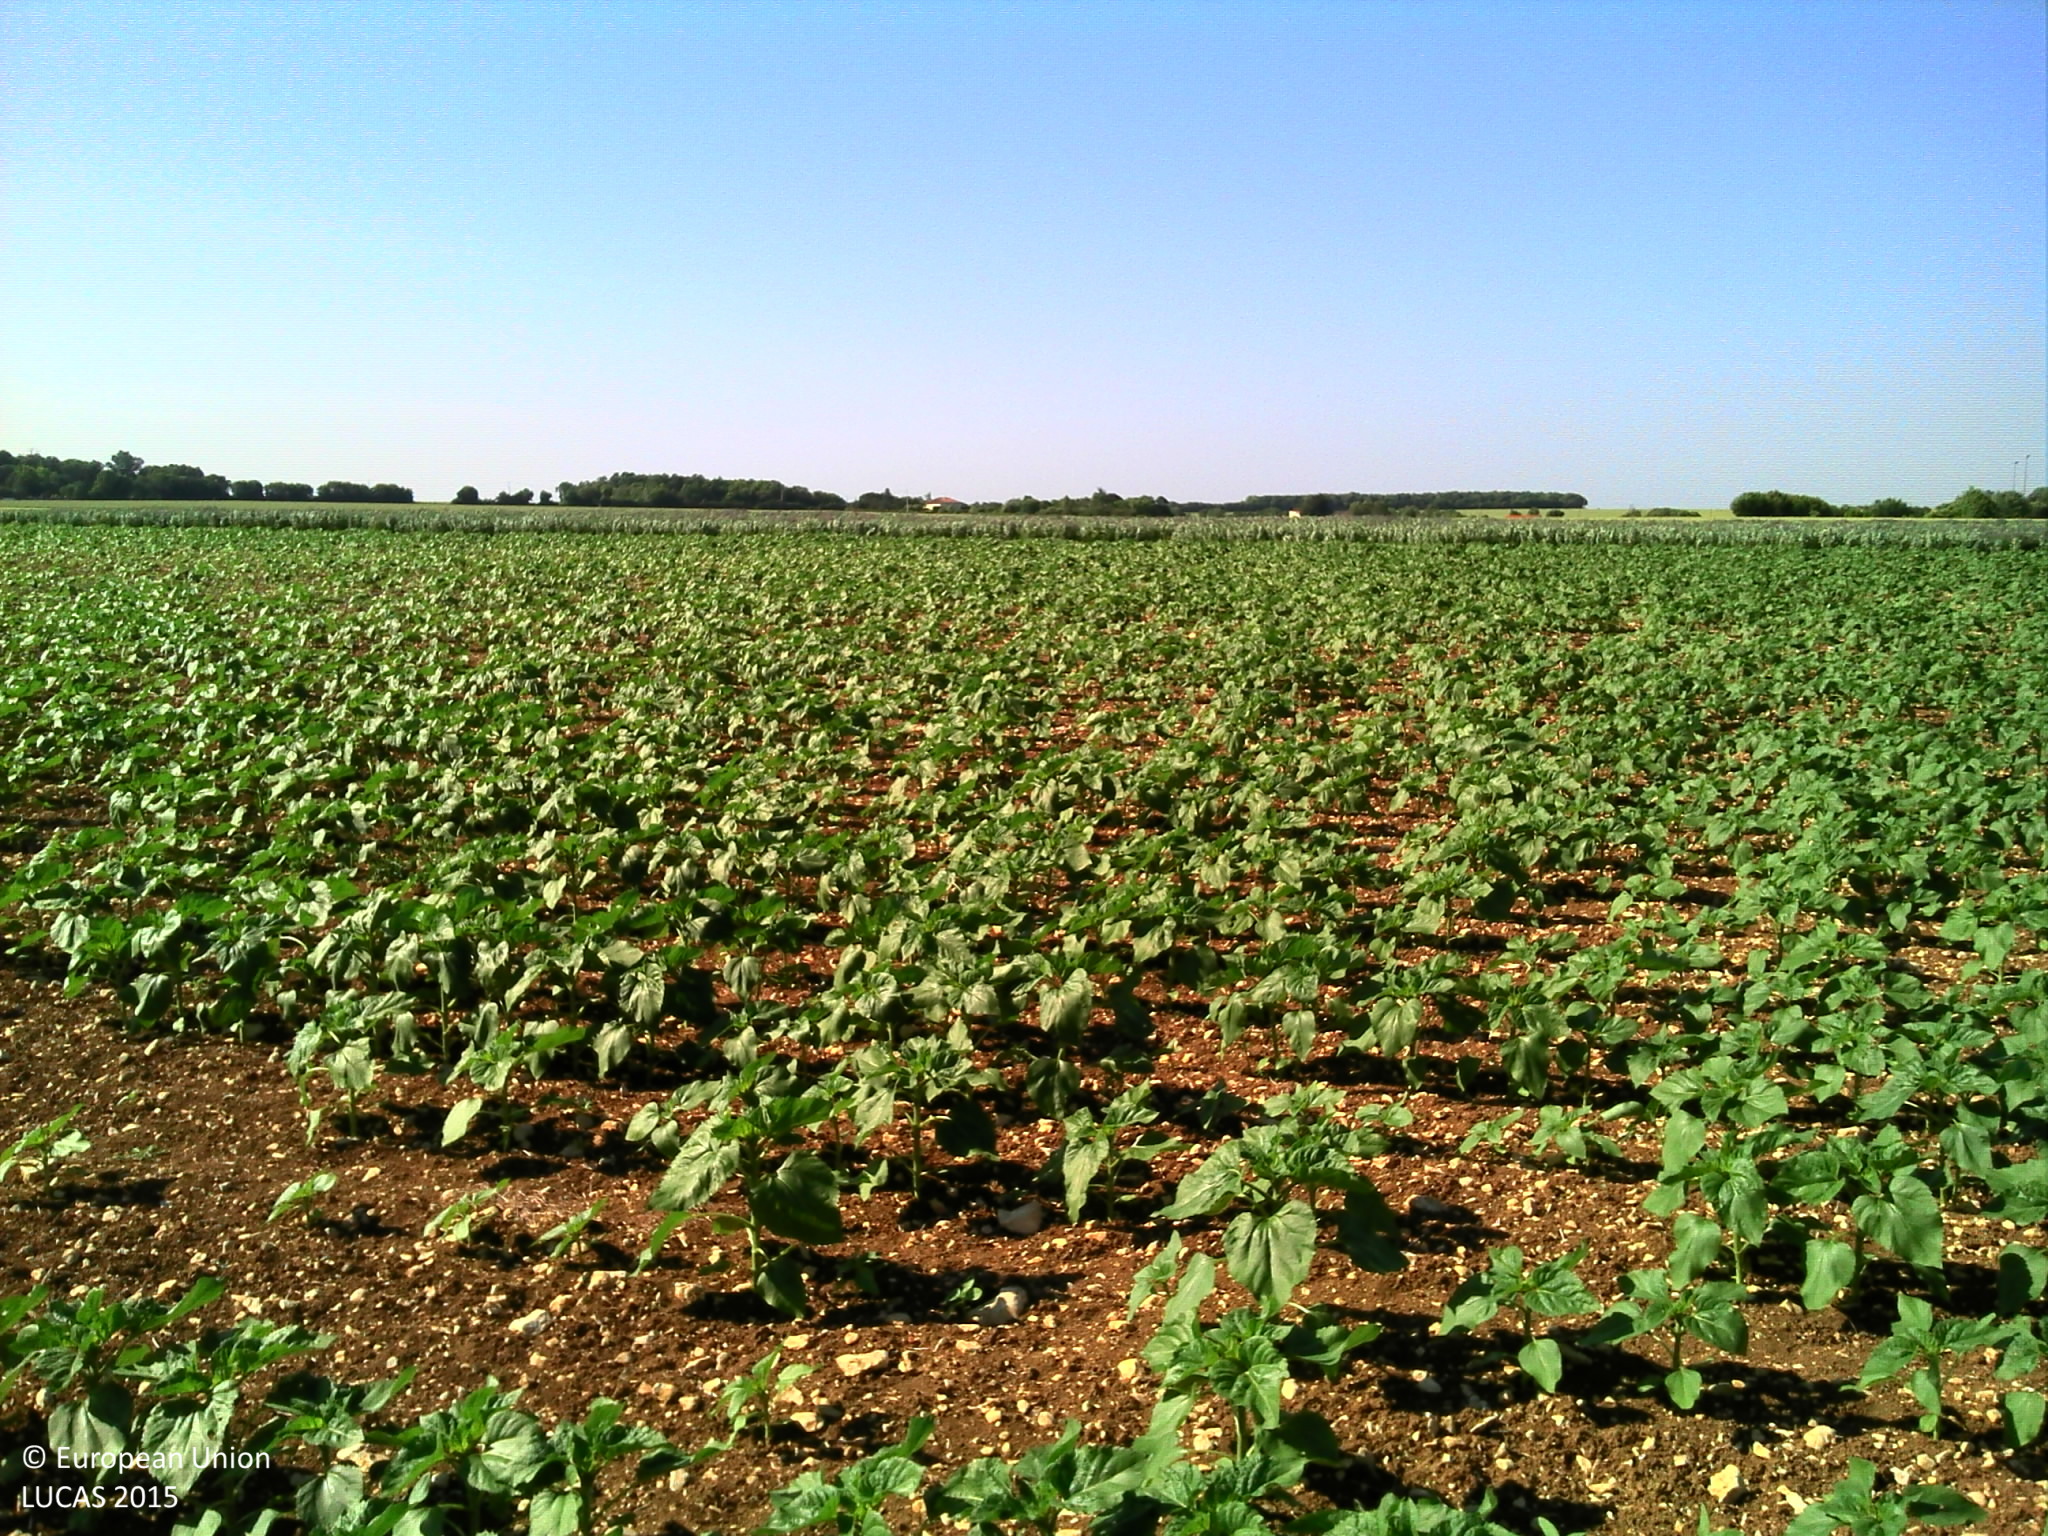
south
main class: Cropland
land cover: Sunflower
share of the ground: > 75 %
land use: Agriculture (excluding fallow land and kitchen gardens)
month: June
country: FR
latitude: 46.1966
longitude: -1.0324
